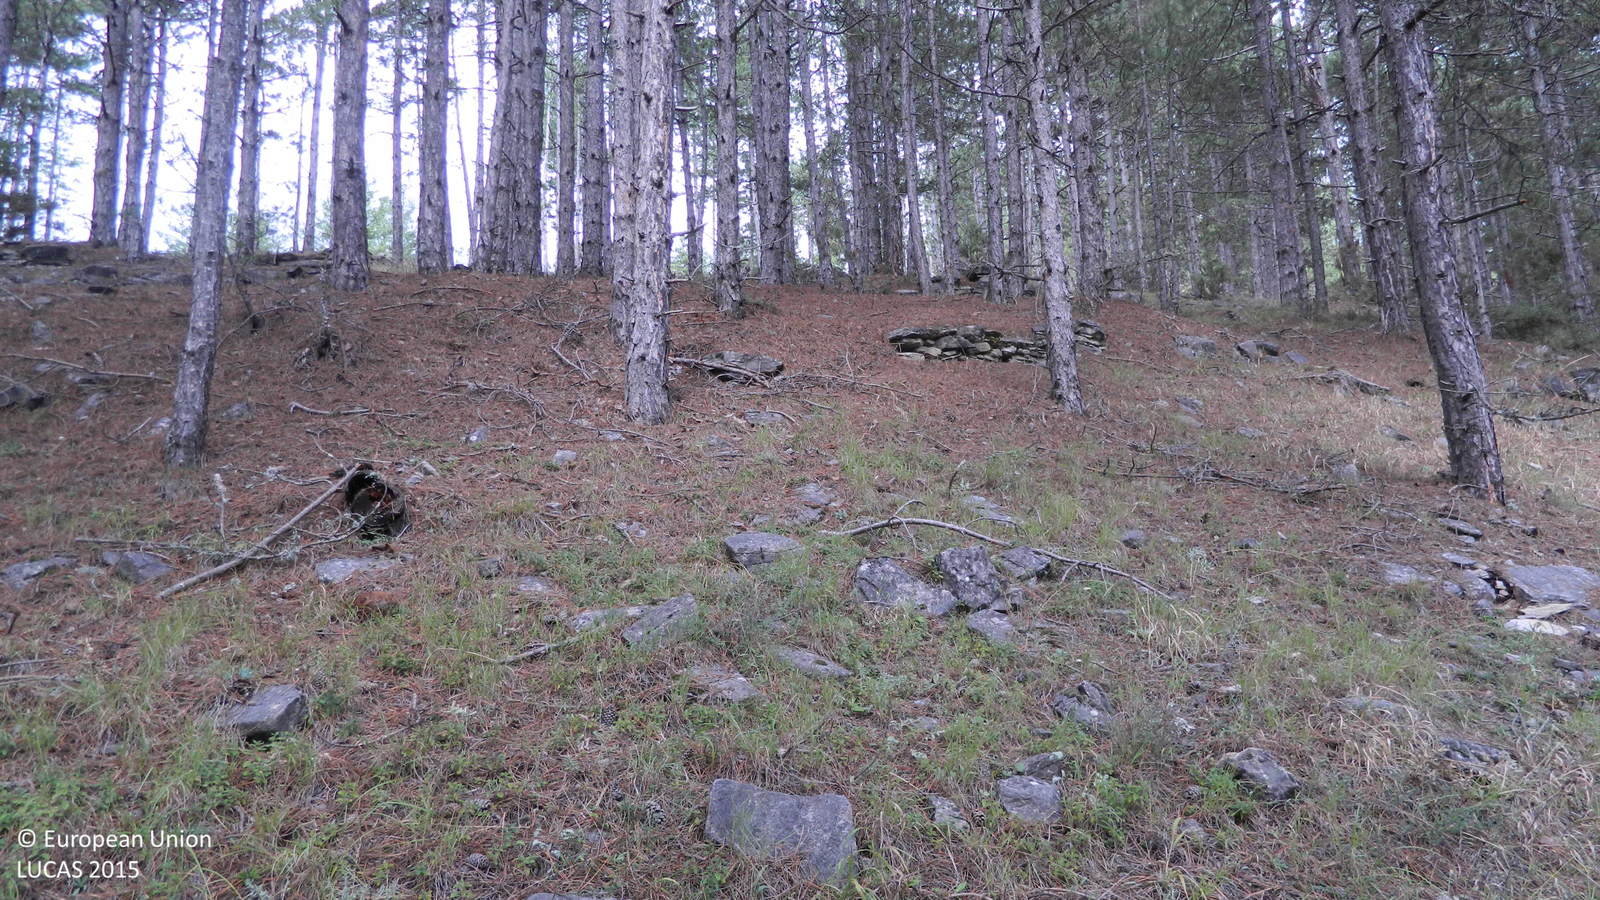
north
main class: Woodland
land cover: Pine dominated coniferous woodland
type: hemiboreal forest and nemoral coniferous forest and mixed broadleaved-coniferous forest
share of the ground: > 75 %
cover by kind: coniferous forest trees 80 %, unconsolidated bare surface 20 %
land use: Forestry
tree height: > 5 m
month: September
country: BG
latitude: 41.4885
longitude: 24.0333
